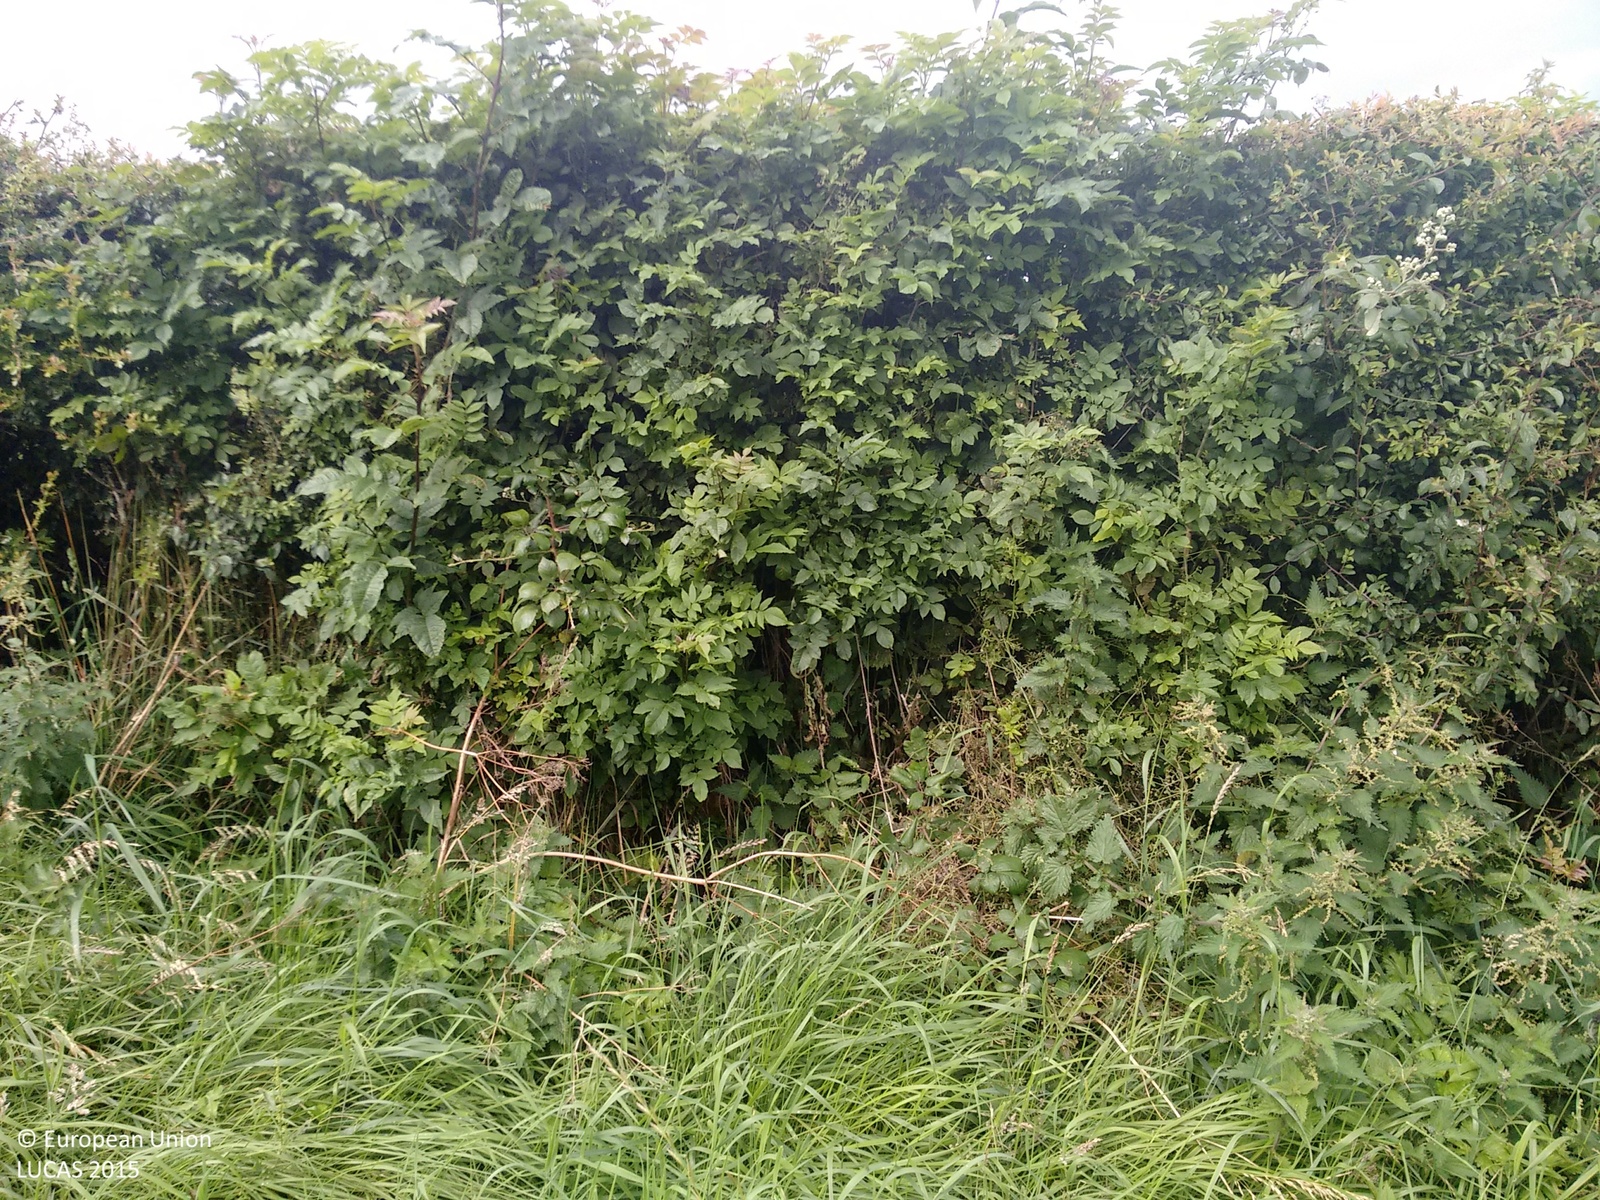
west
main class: Grassland
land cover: Grassland without tree/shrub cover
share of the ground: > 75 %
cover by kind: herbaceous plants 100 %
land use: Agriculture (excluding fallow land and kitchen gardens)
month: August
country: GB
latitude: 54.3114
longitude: -6.8114
